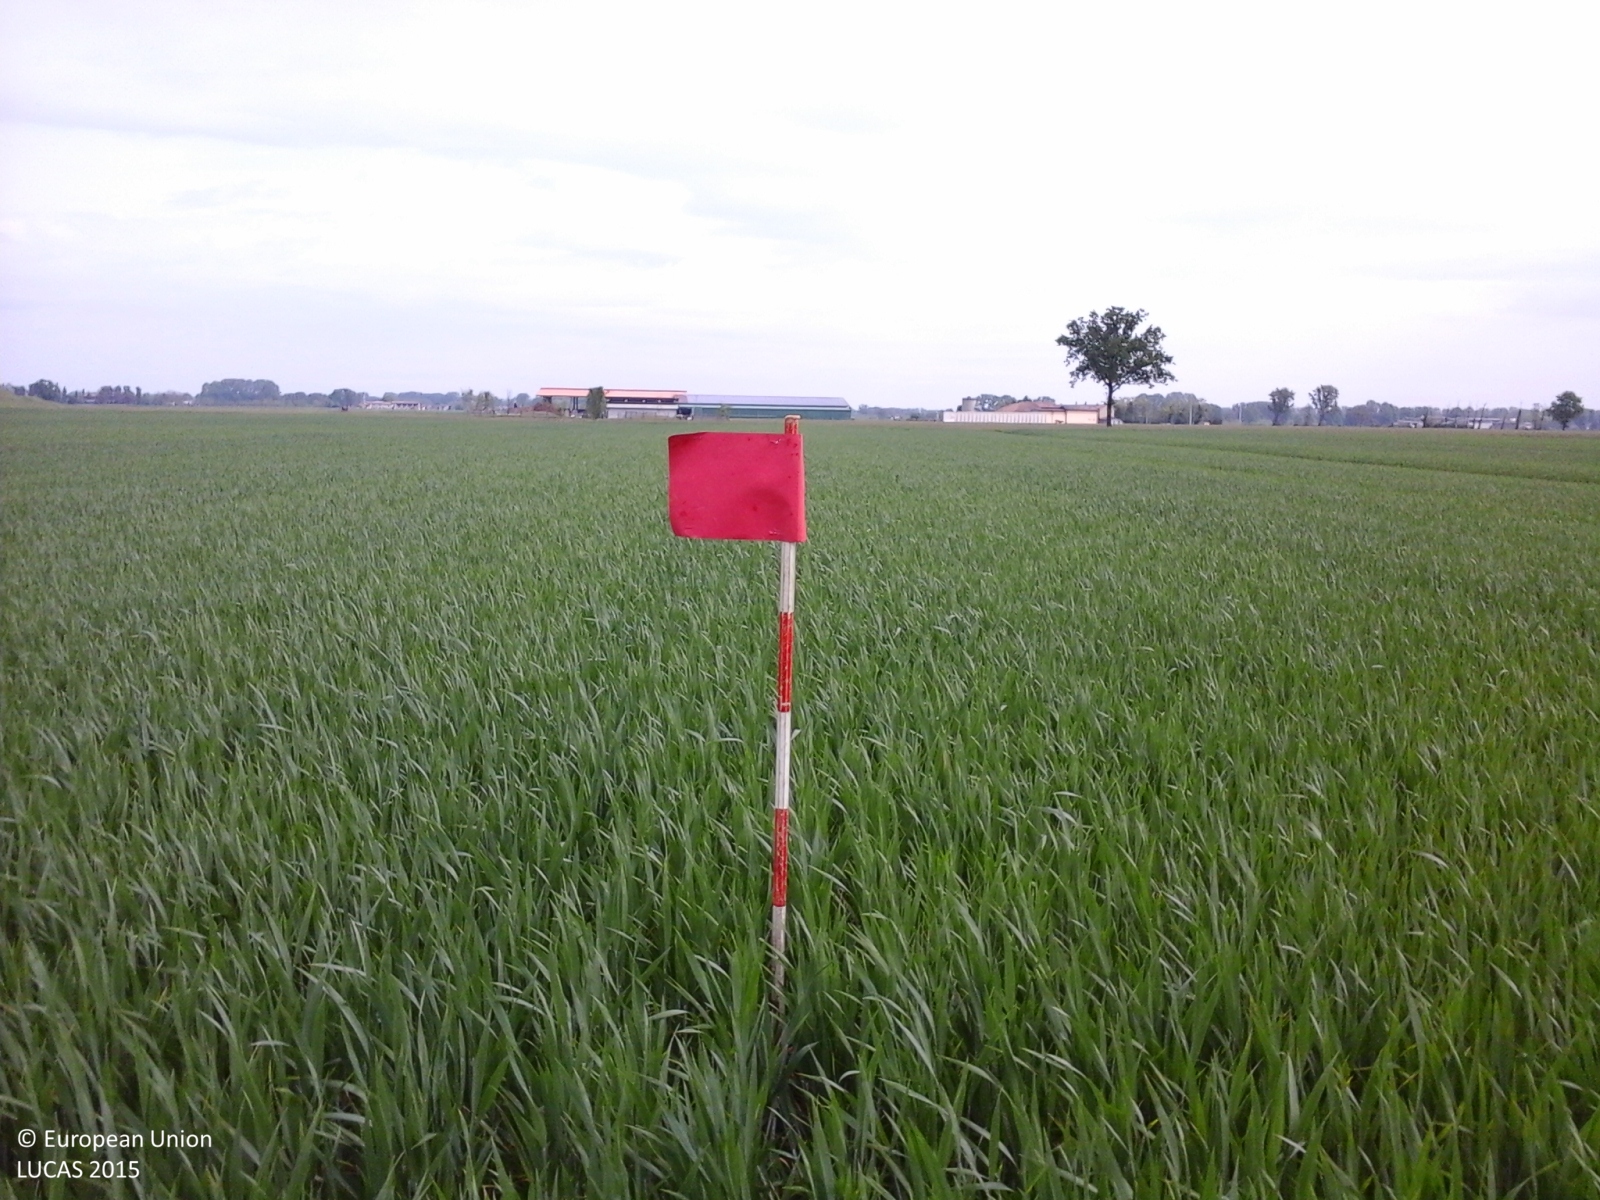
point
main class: Cropland
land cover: Common wheat
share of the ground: > 75 %
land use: Agriculture (excluding fallow land and kitchen gardens)
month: April
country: IT
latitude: 45.0889
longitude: 9.5562
